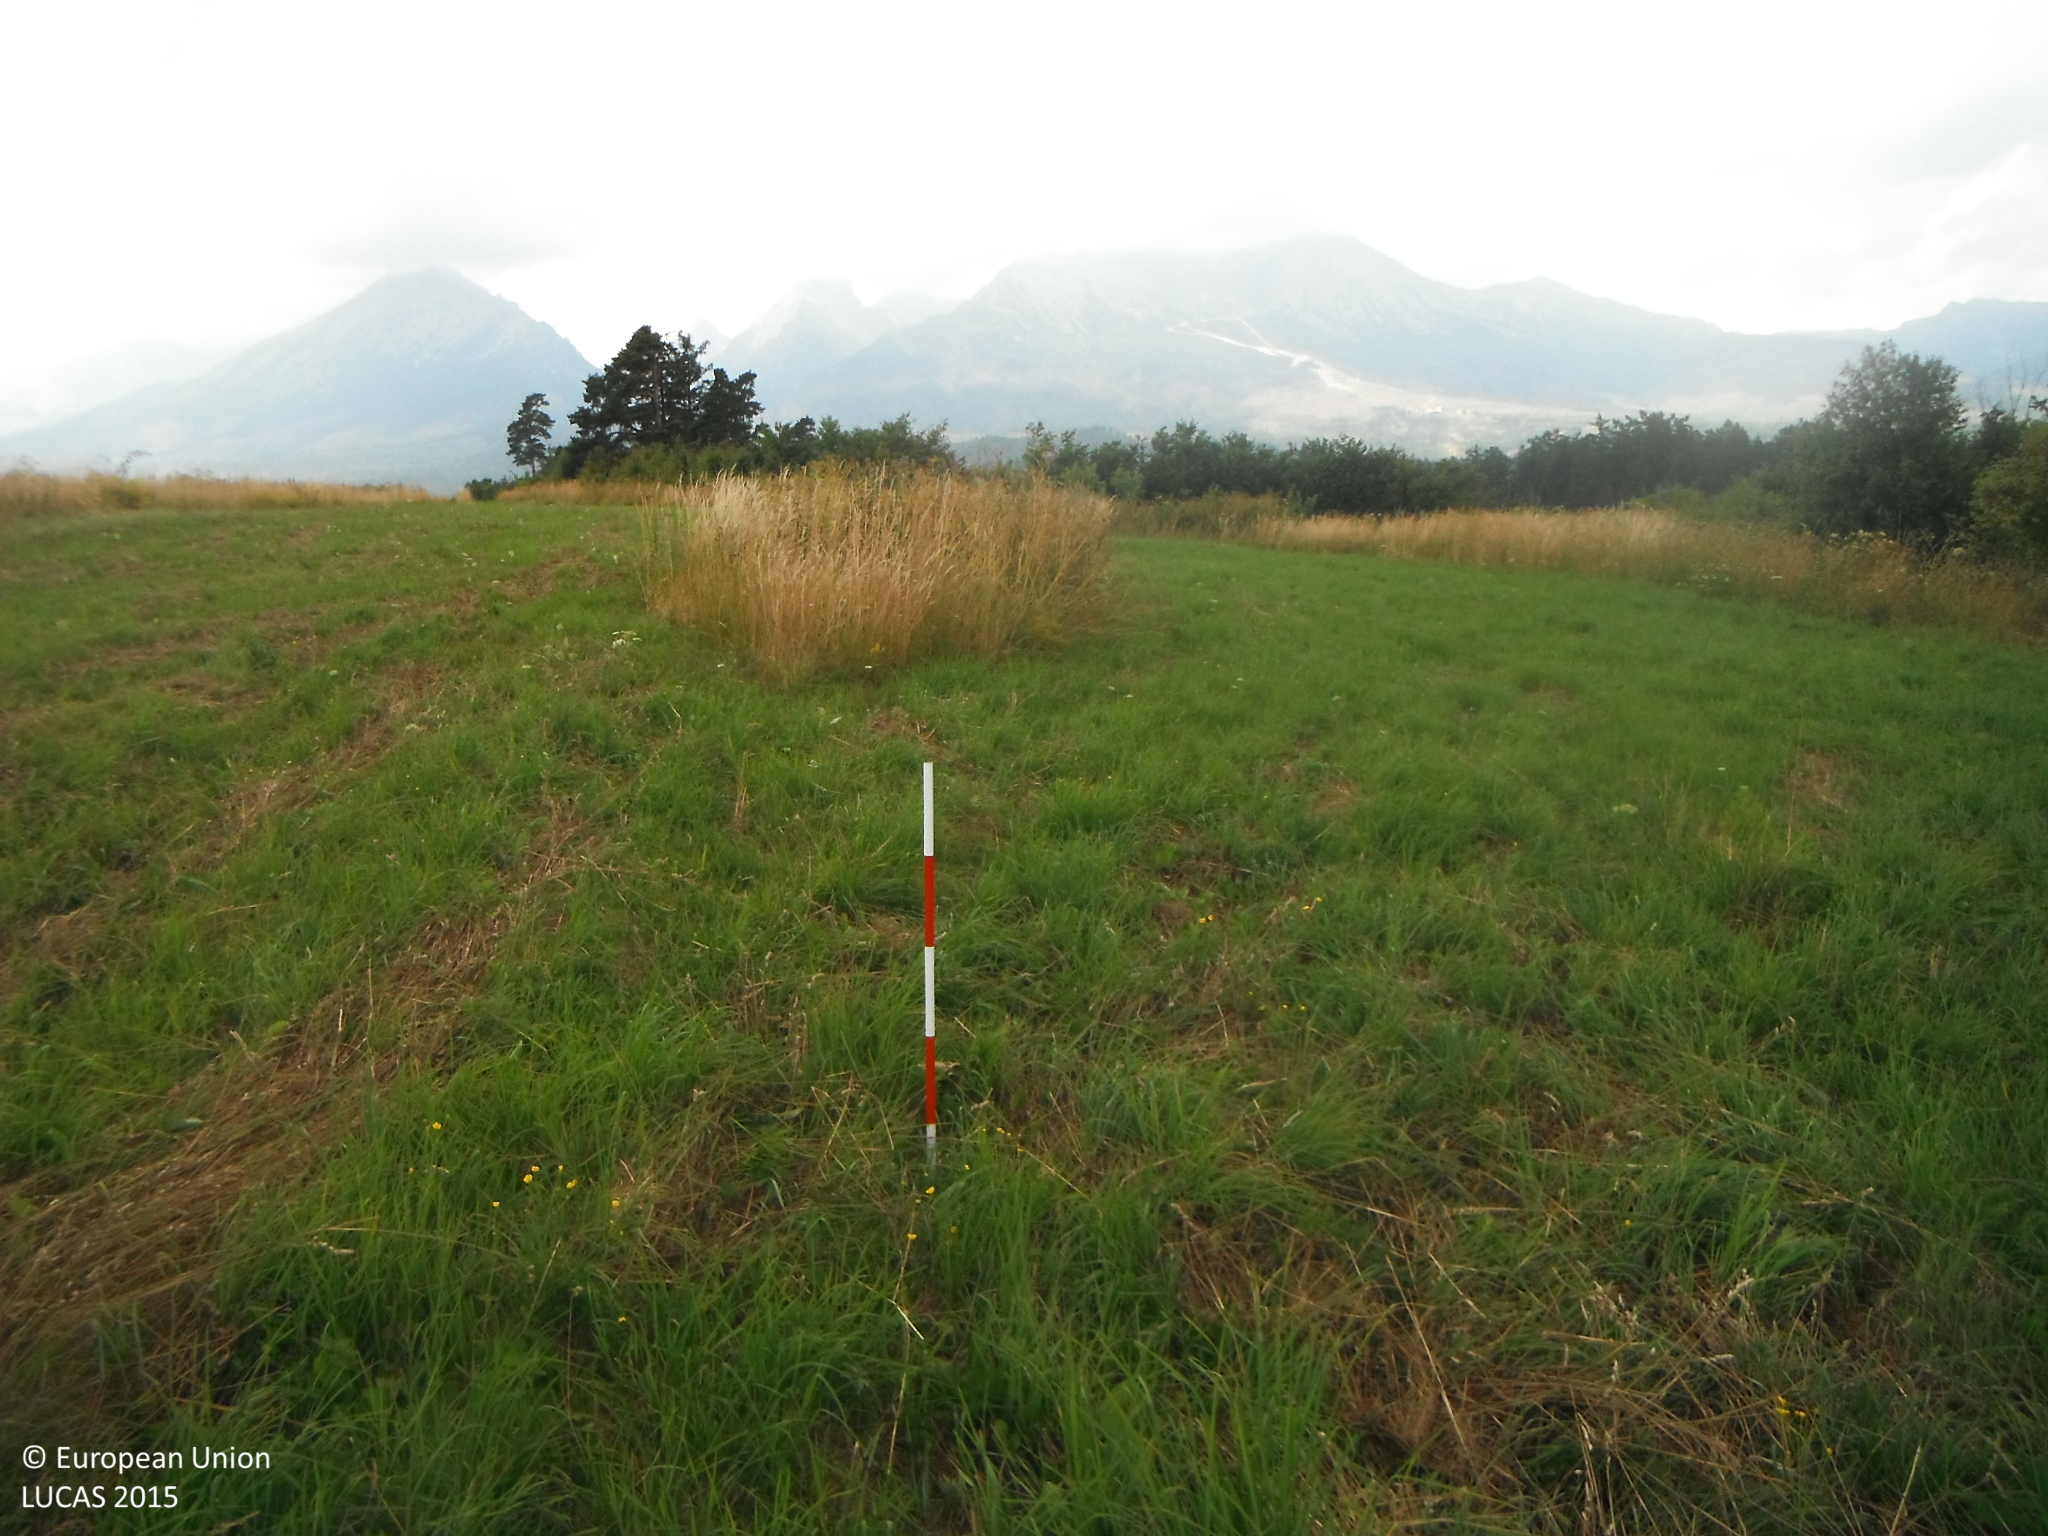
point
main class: Grassland
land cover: Grassland without tree/shrub cover
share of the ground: > 75 %
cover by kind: herbaceous plants 100 %
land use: Agriculture (excluding fallow land and kitchen gardens)
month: July
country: SK
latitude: 49.1362
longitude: 20.3002
